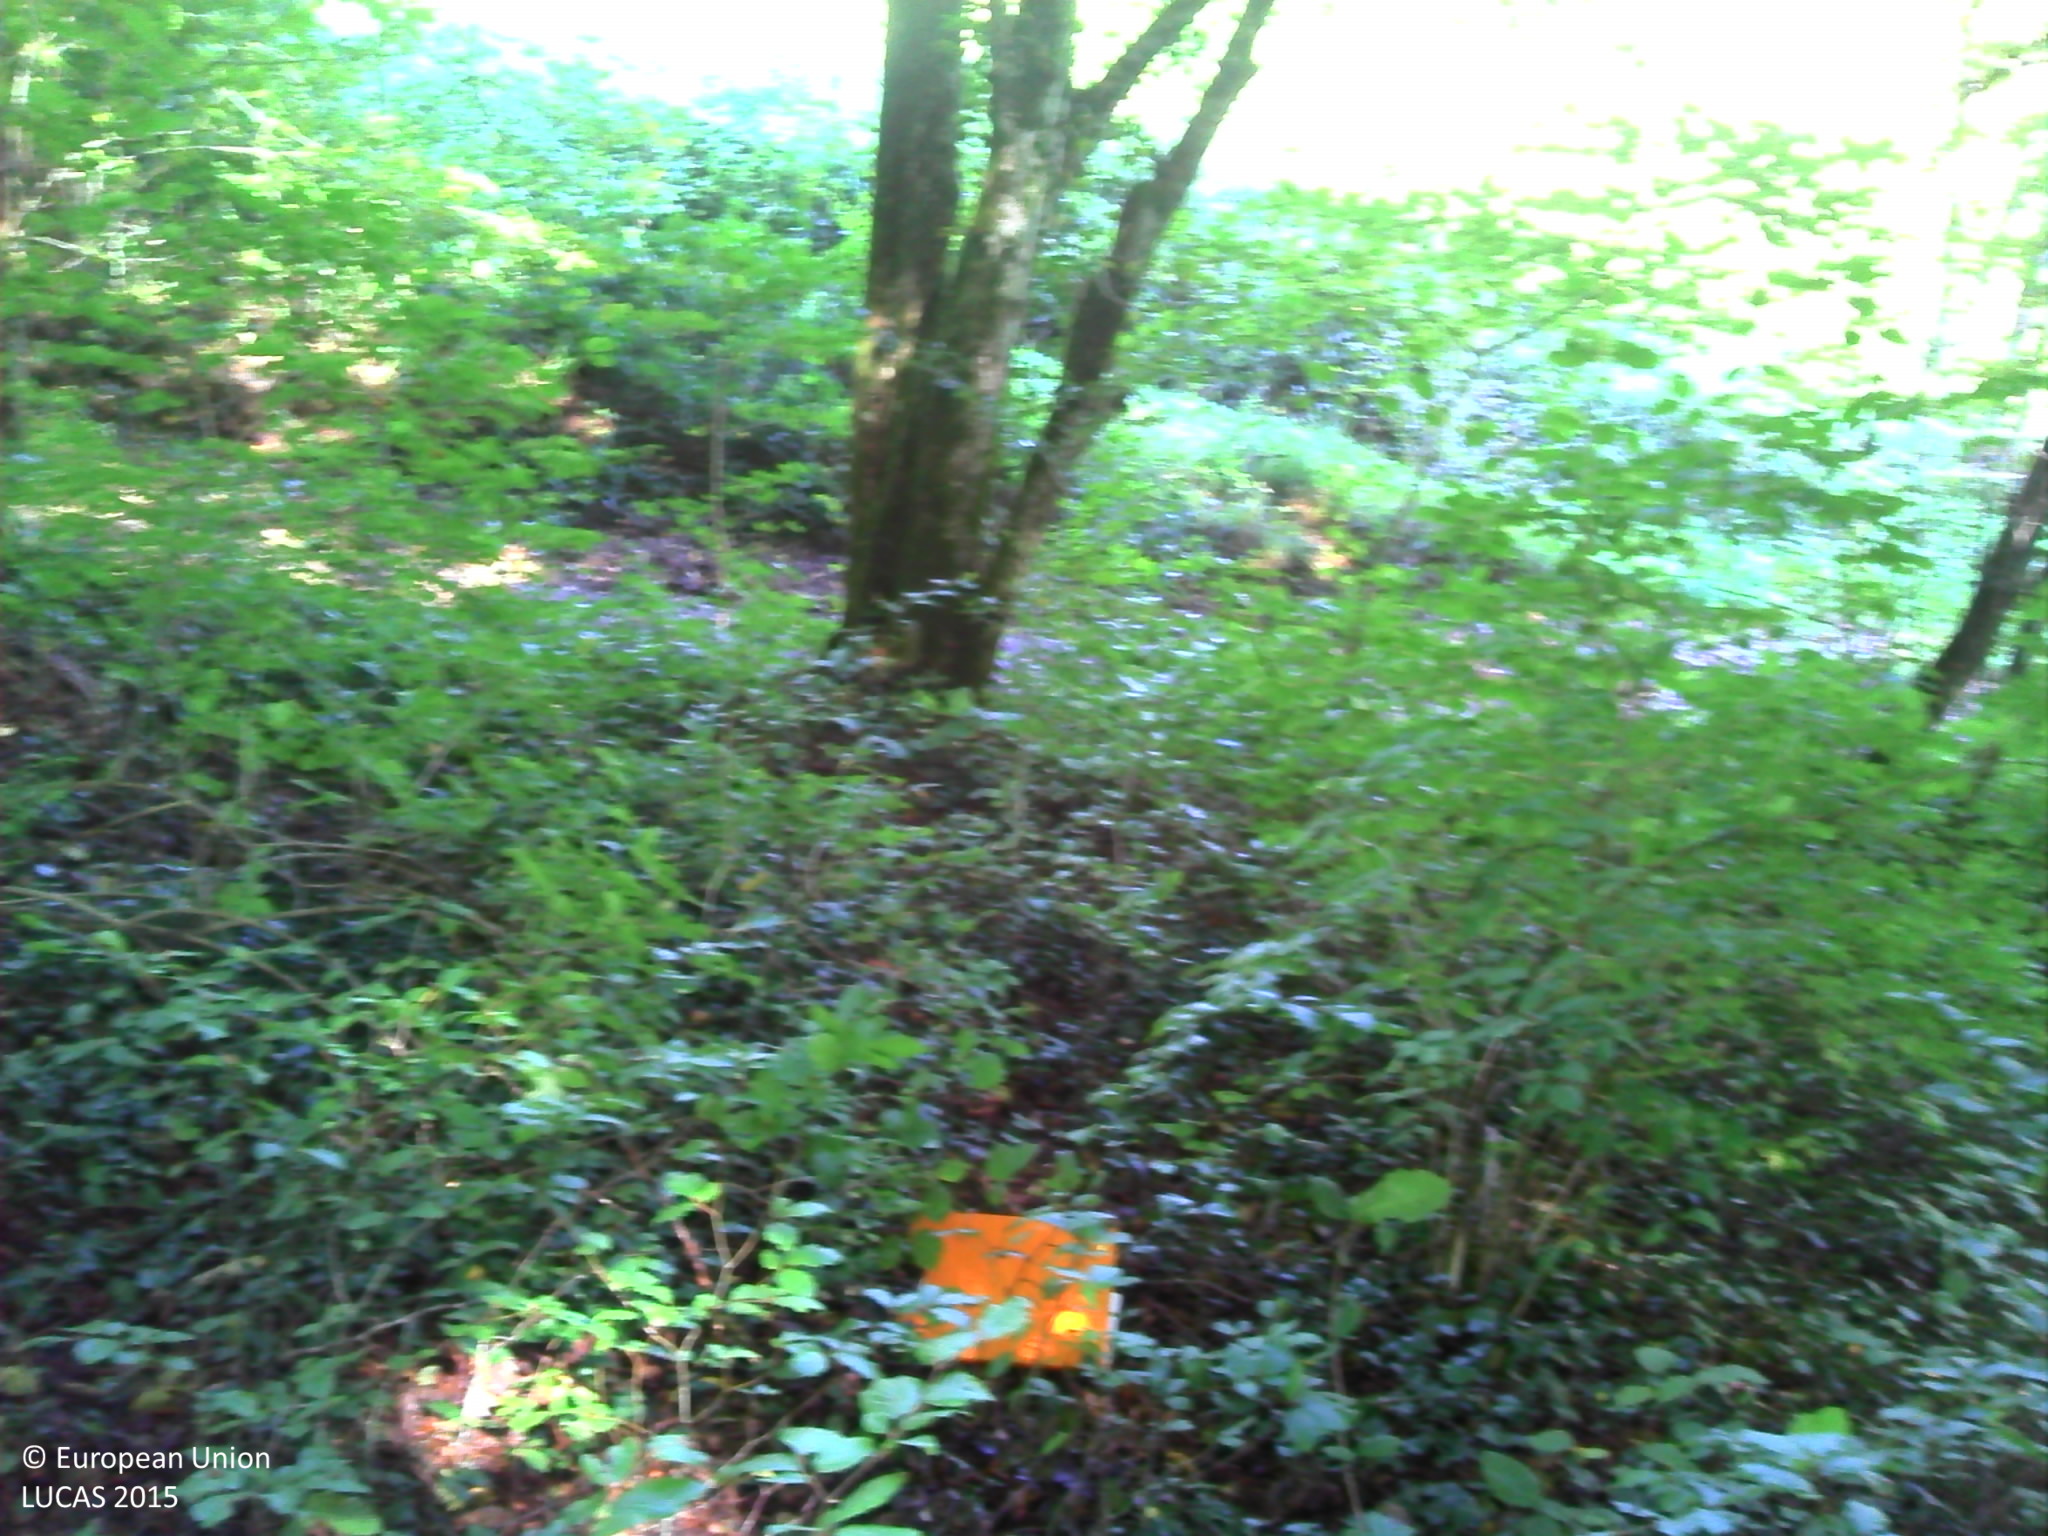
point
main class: Woodland
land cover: Broadleaved woodland
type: mesophytic deciduous forest
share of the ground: > 75 %
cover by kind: broadleaved forest trees 90 %, shrubs 5 %, herbaceous plants 5 %
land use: Forestry
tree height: > 5 m
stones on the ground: < 10 %
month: September
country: FR
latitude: 47.4052
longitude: 6.8877
